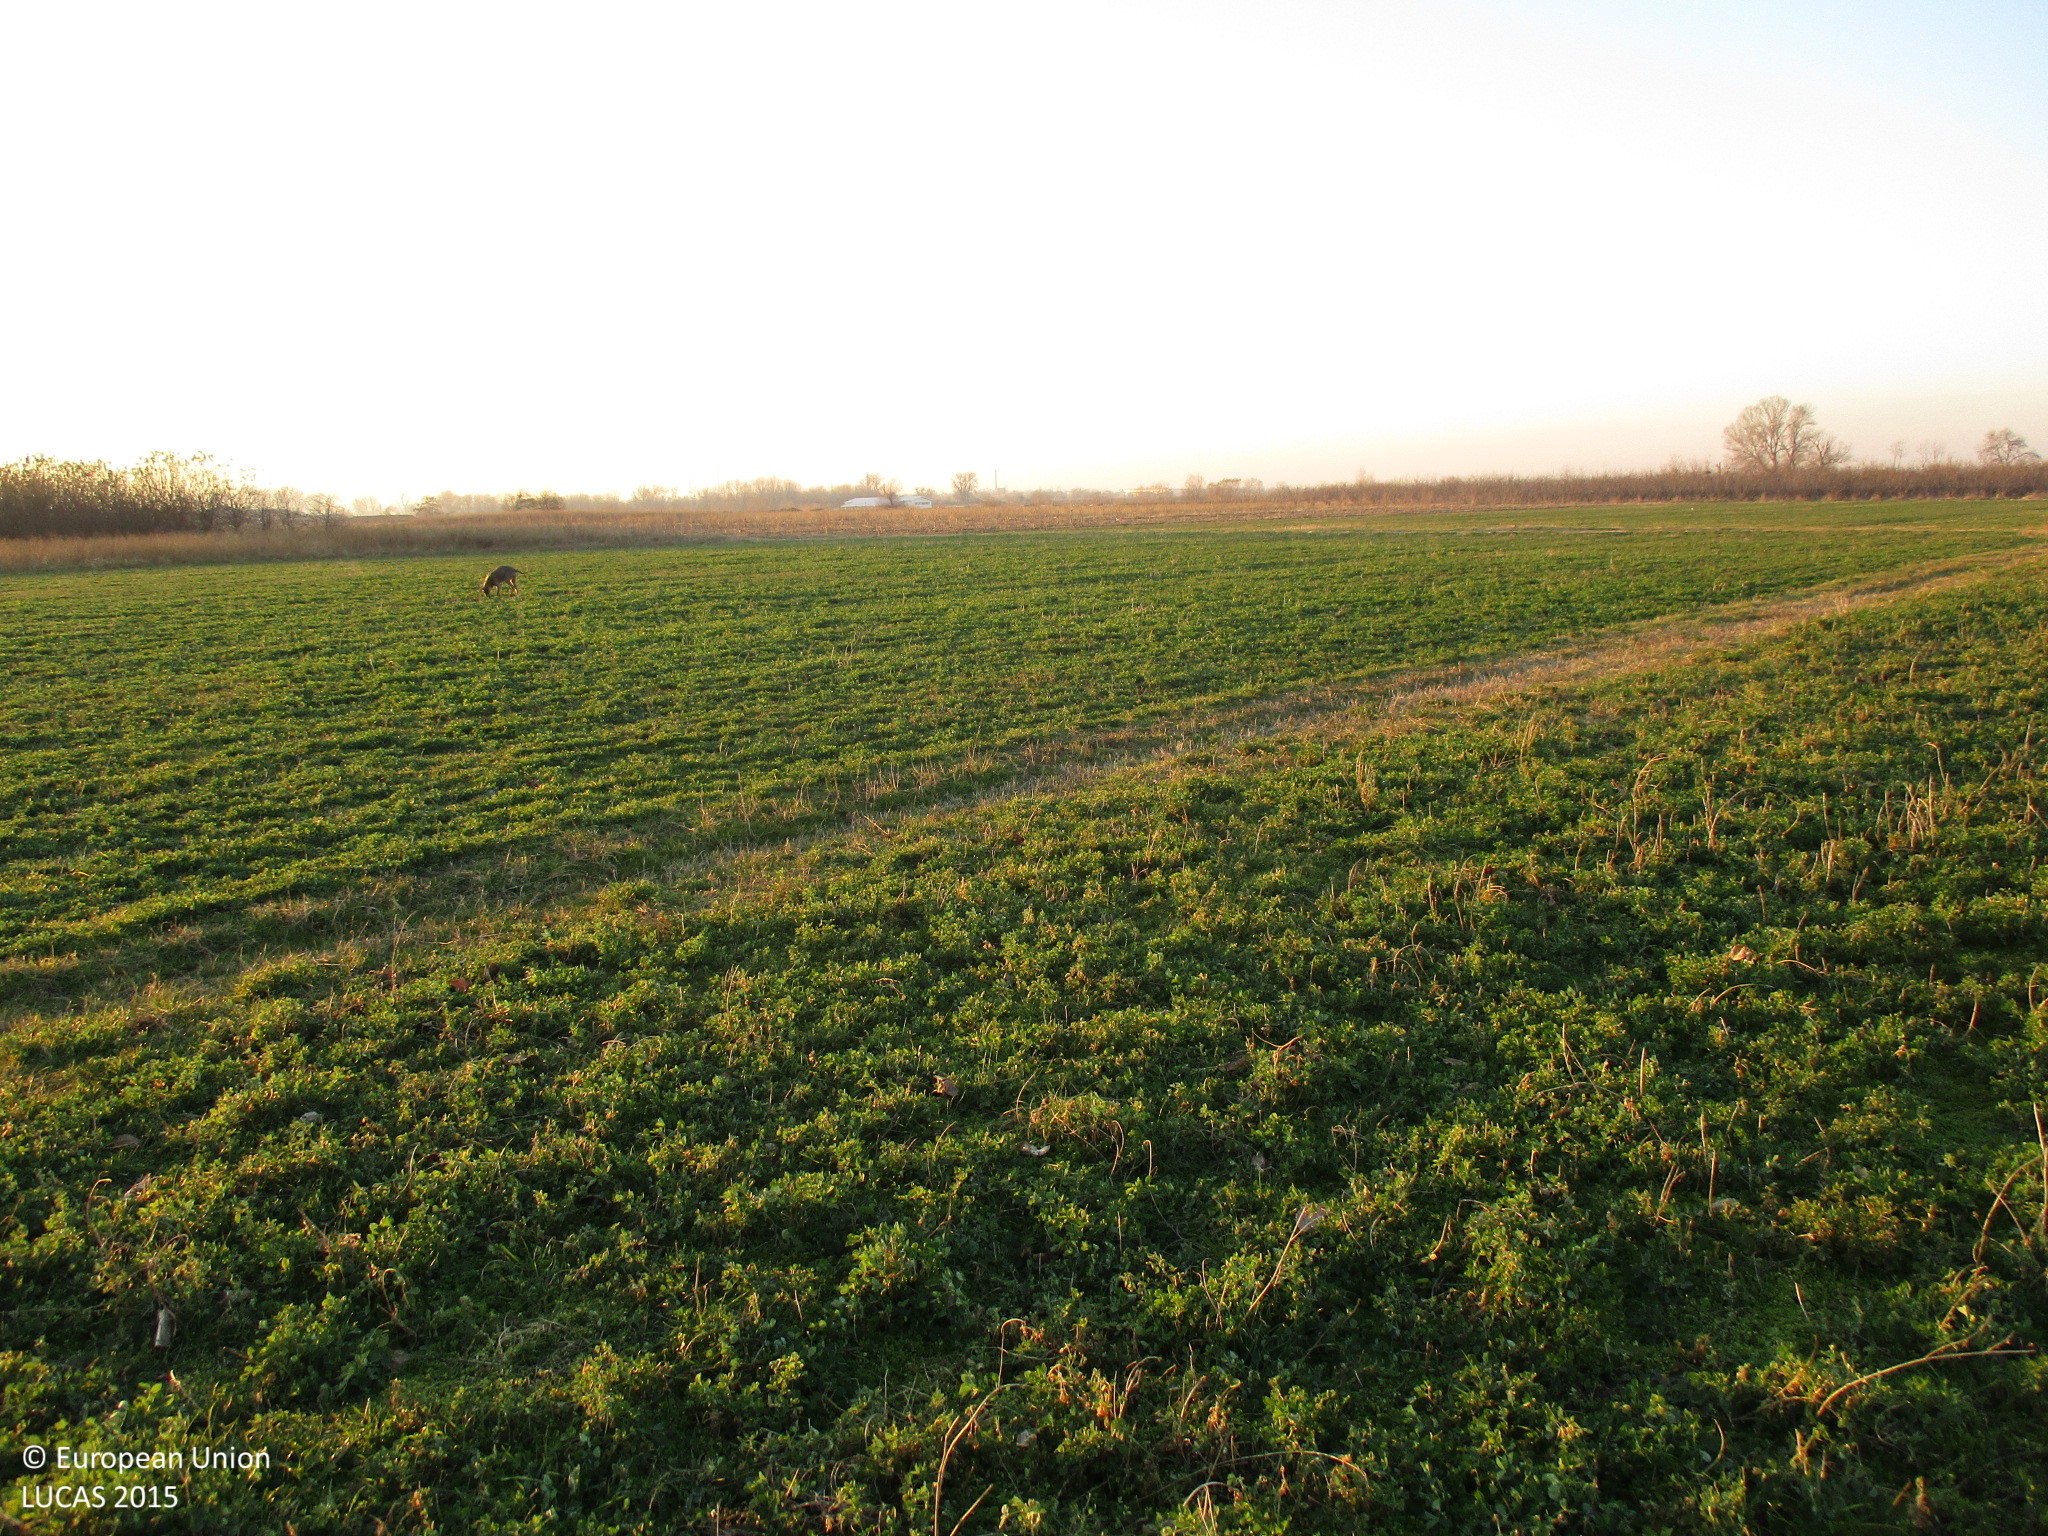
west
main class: Cropland
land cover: Lucerne
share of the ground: 50 - 75 %
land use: Agriculture (excluding fallow land and kitchen gardens)
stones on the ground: < 10 %
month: December
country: BG
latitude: 42.1245
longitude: 24.5759
